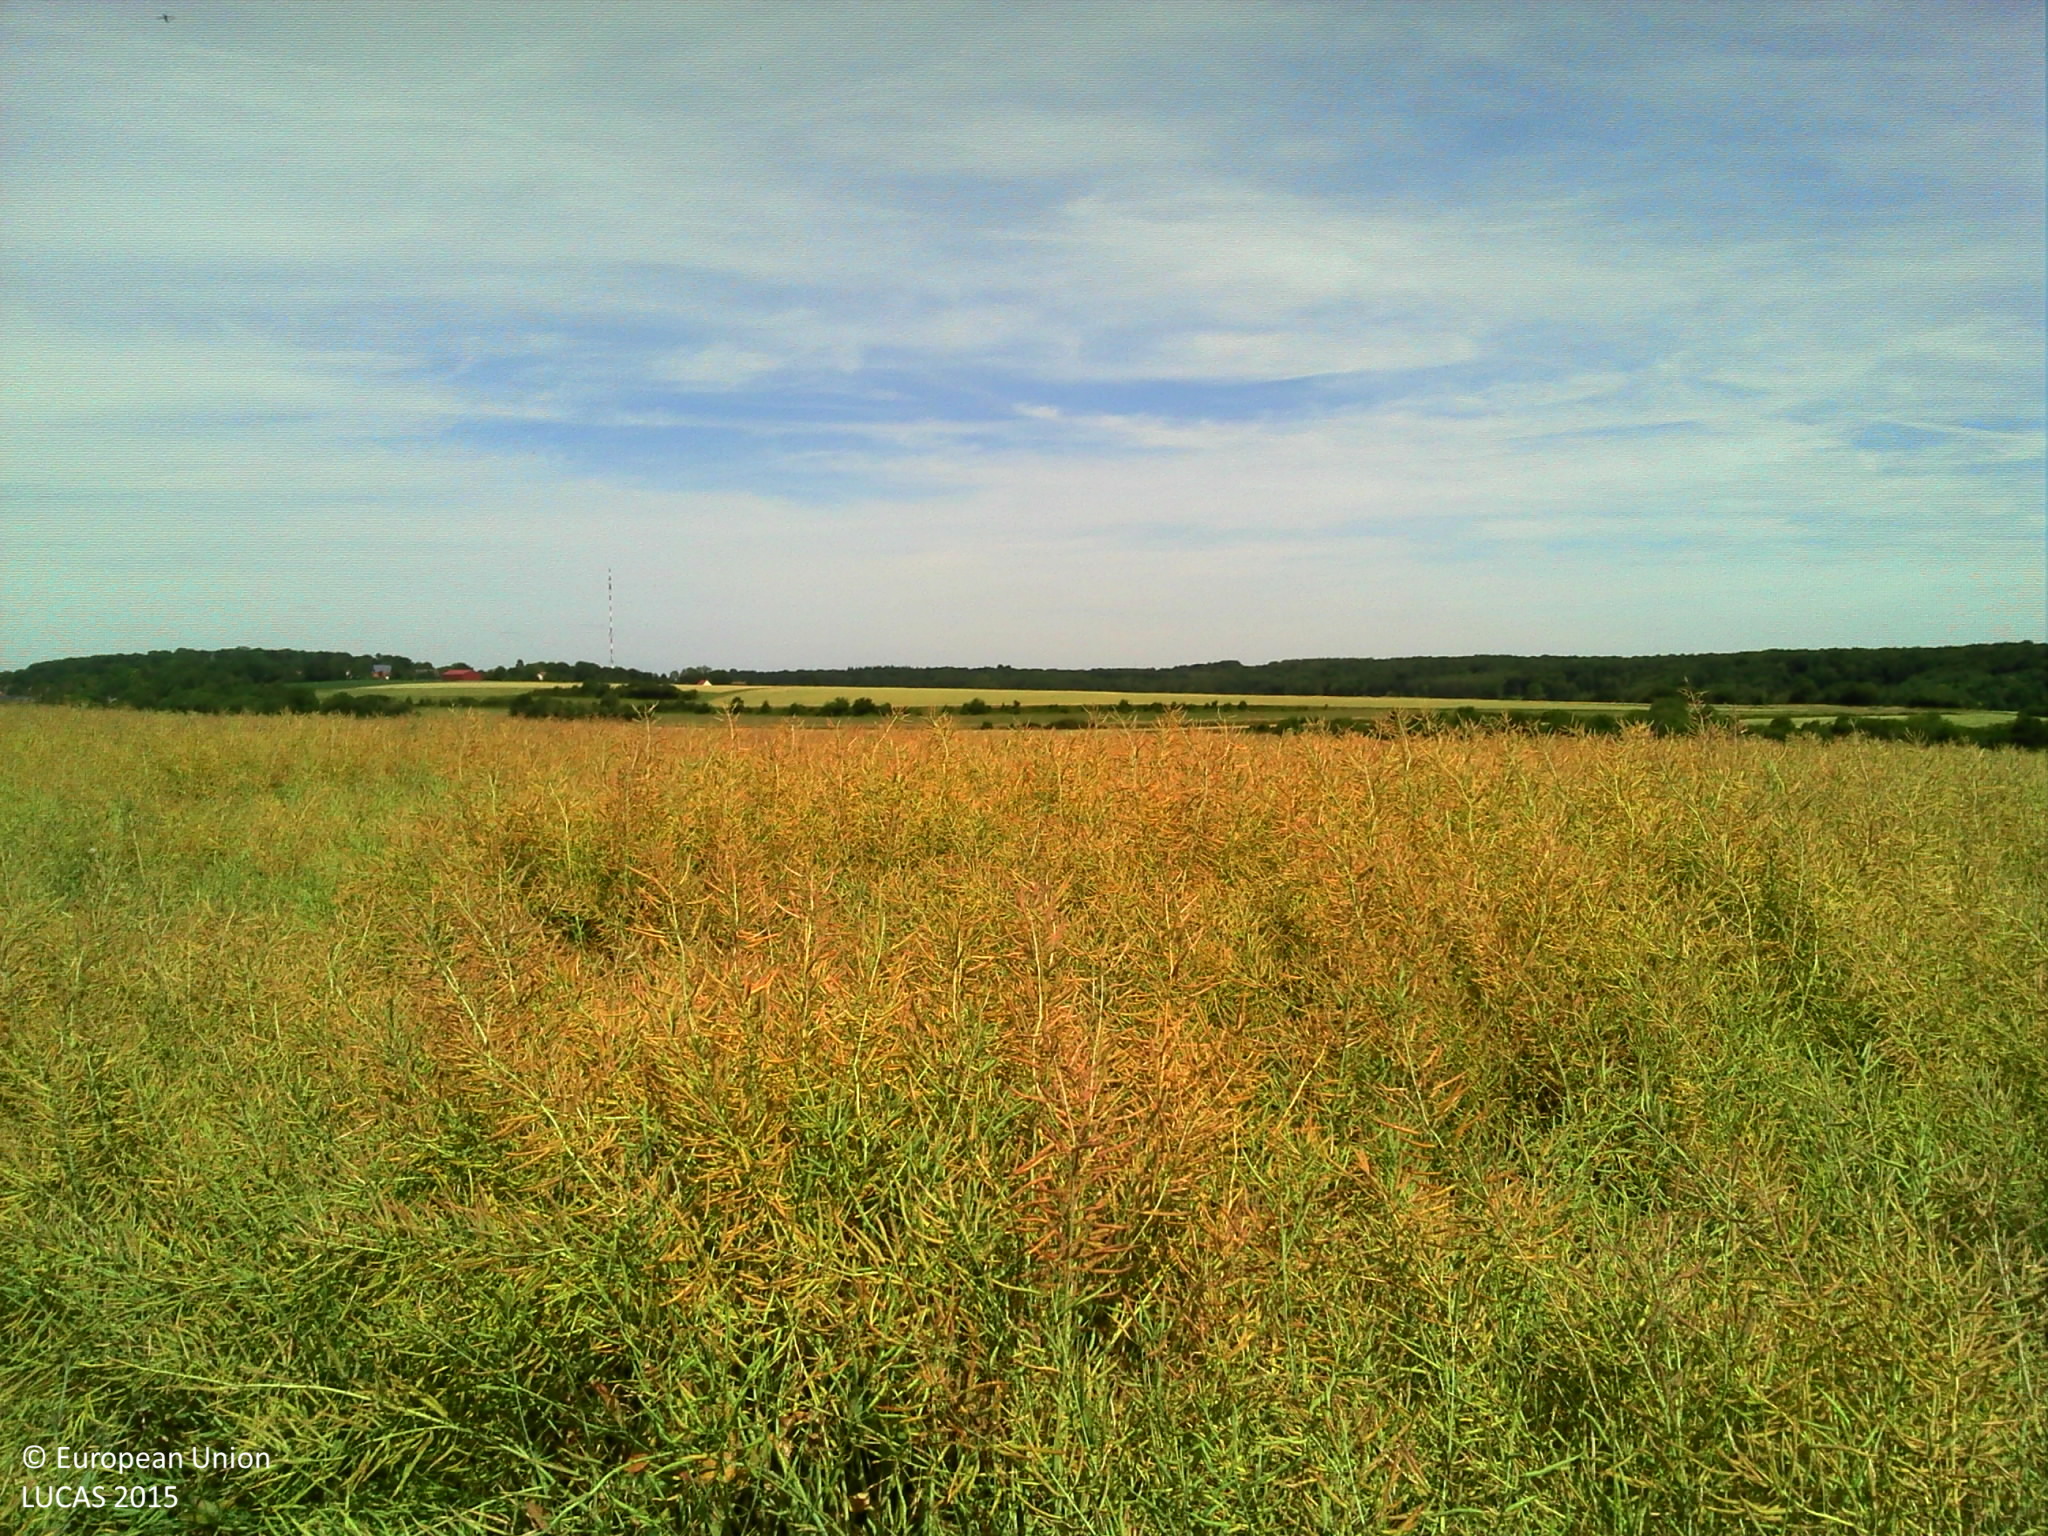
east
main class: Cropland
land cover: Rape and turnip rape
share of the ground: > 75 %
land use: Agriculture (excluding fallow land and kitchen gardens)
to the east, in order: Rape and turnip rape; Common wheat
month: June
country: FR
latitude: 49.4936
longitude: 2.3523
